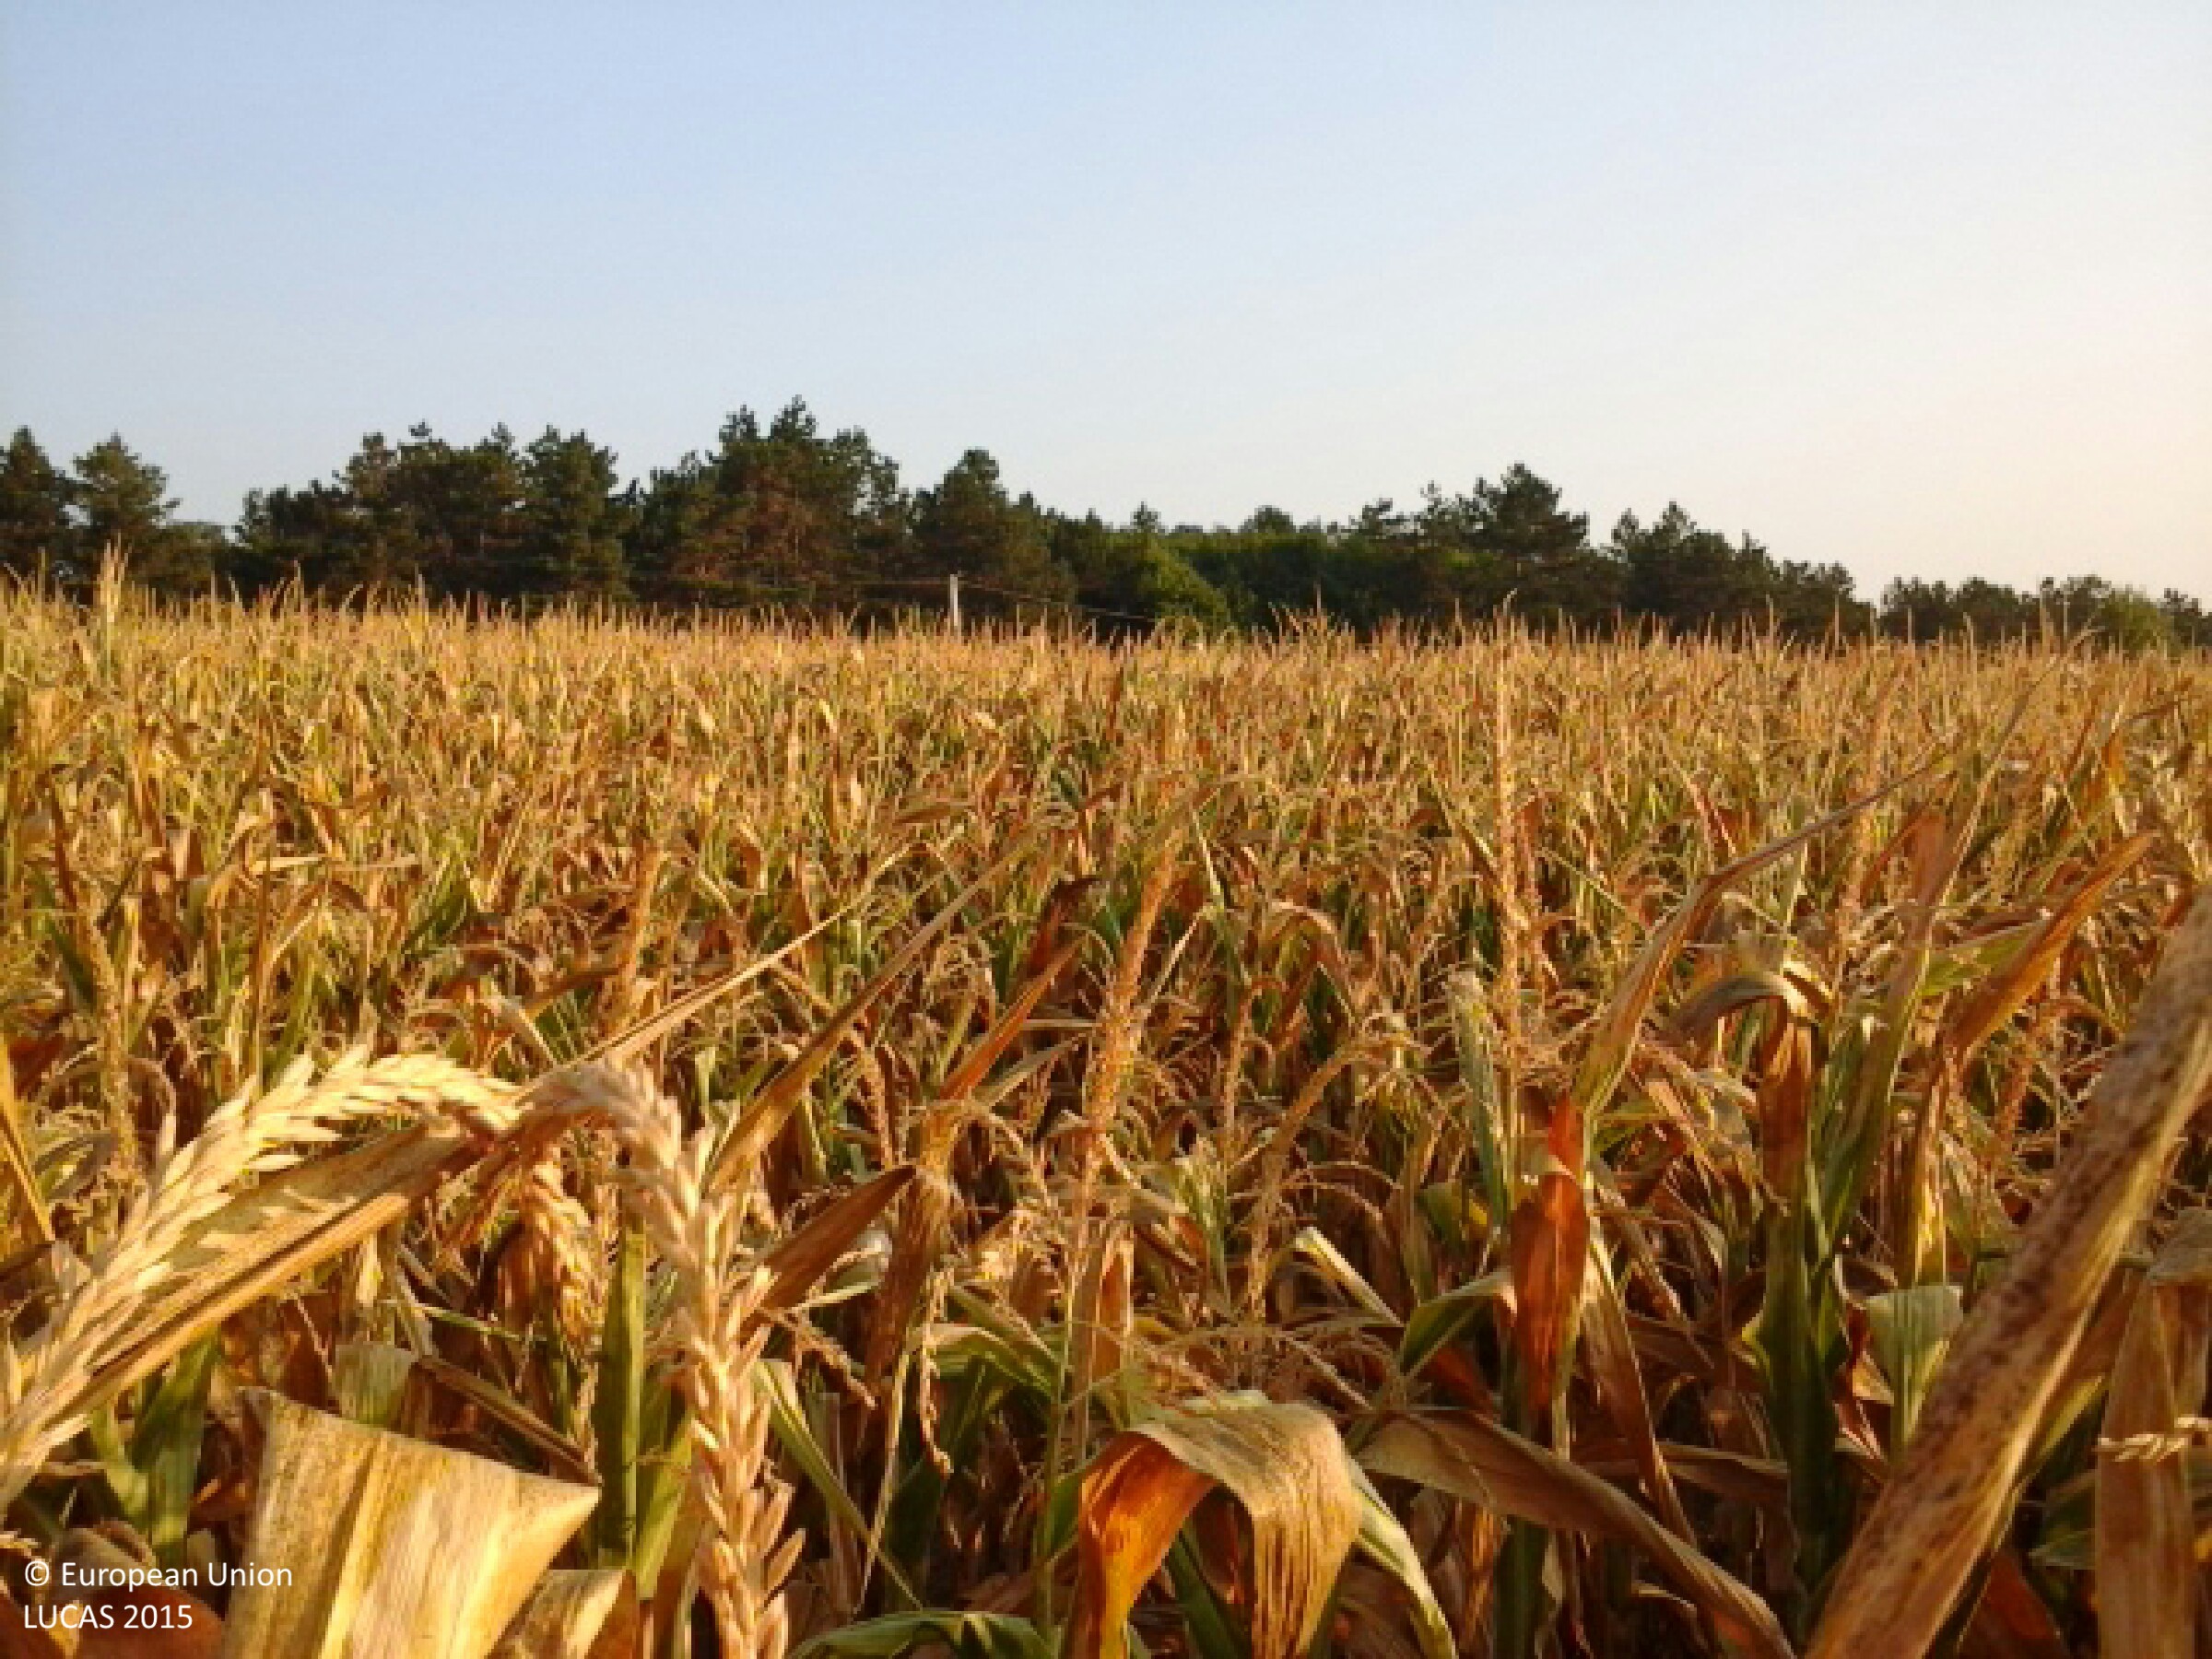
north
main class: Cropland
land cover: Maize
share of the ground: > 75 %
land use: Agriculture (excluding fallow land and kitchen gardens)
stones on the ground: < 10 %
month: August
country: HU
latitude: 47.2606
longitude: 18.5106
